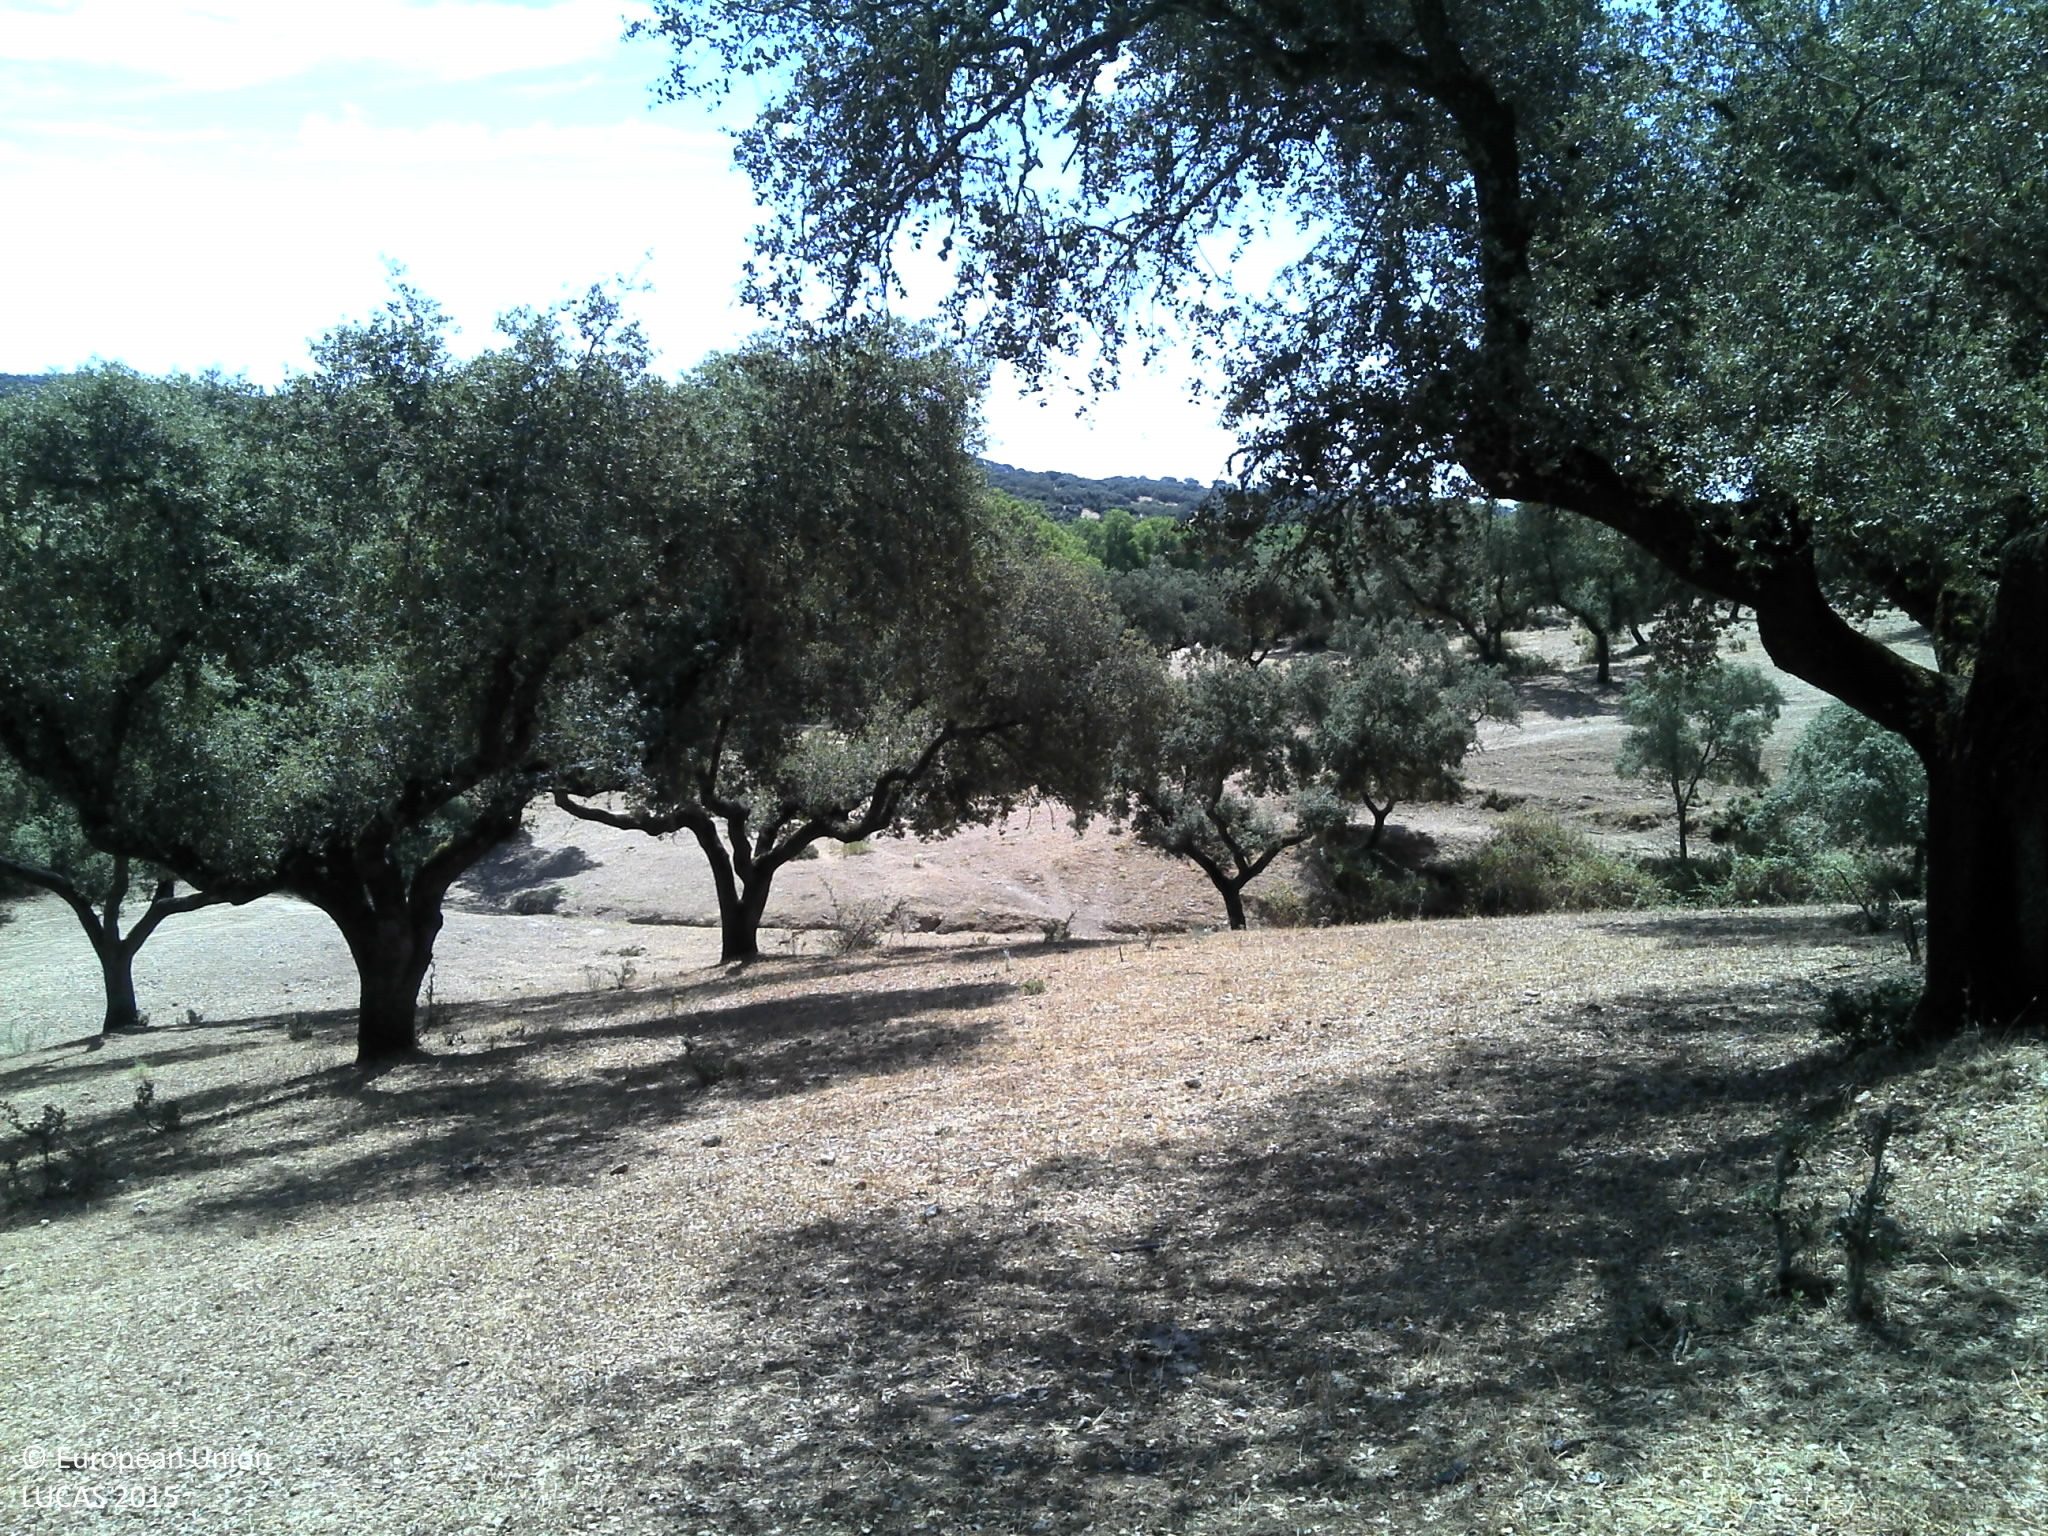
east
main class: Woodland
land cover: Broadleaved woodland
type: broadleaved evergreen forest
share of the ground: 25 - 50 %
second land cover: Grassland without tree/shrub cover
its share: 10 - 25 %
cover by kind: unconsolidated bare surface 55 %, broadleaved forest trees 30 %, herbaceous plants 15 %
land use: Forestry
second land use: Agriculture (excluding fallow land and kitchen gardens)
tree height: > 5 m
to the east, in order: Broadleaved woodland; Grassland without tree/shrub cover; Broadleaved woodland; Tracks; Abandoned hedges; Inland fresh running water; Abandoned hedges; Grassland with sparse tree/shrub cover
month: July
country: PT
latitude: 38.4953
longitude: -7.7017
